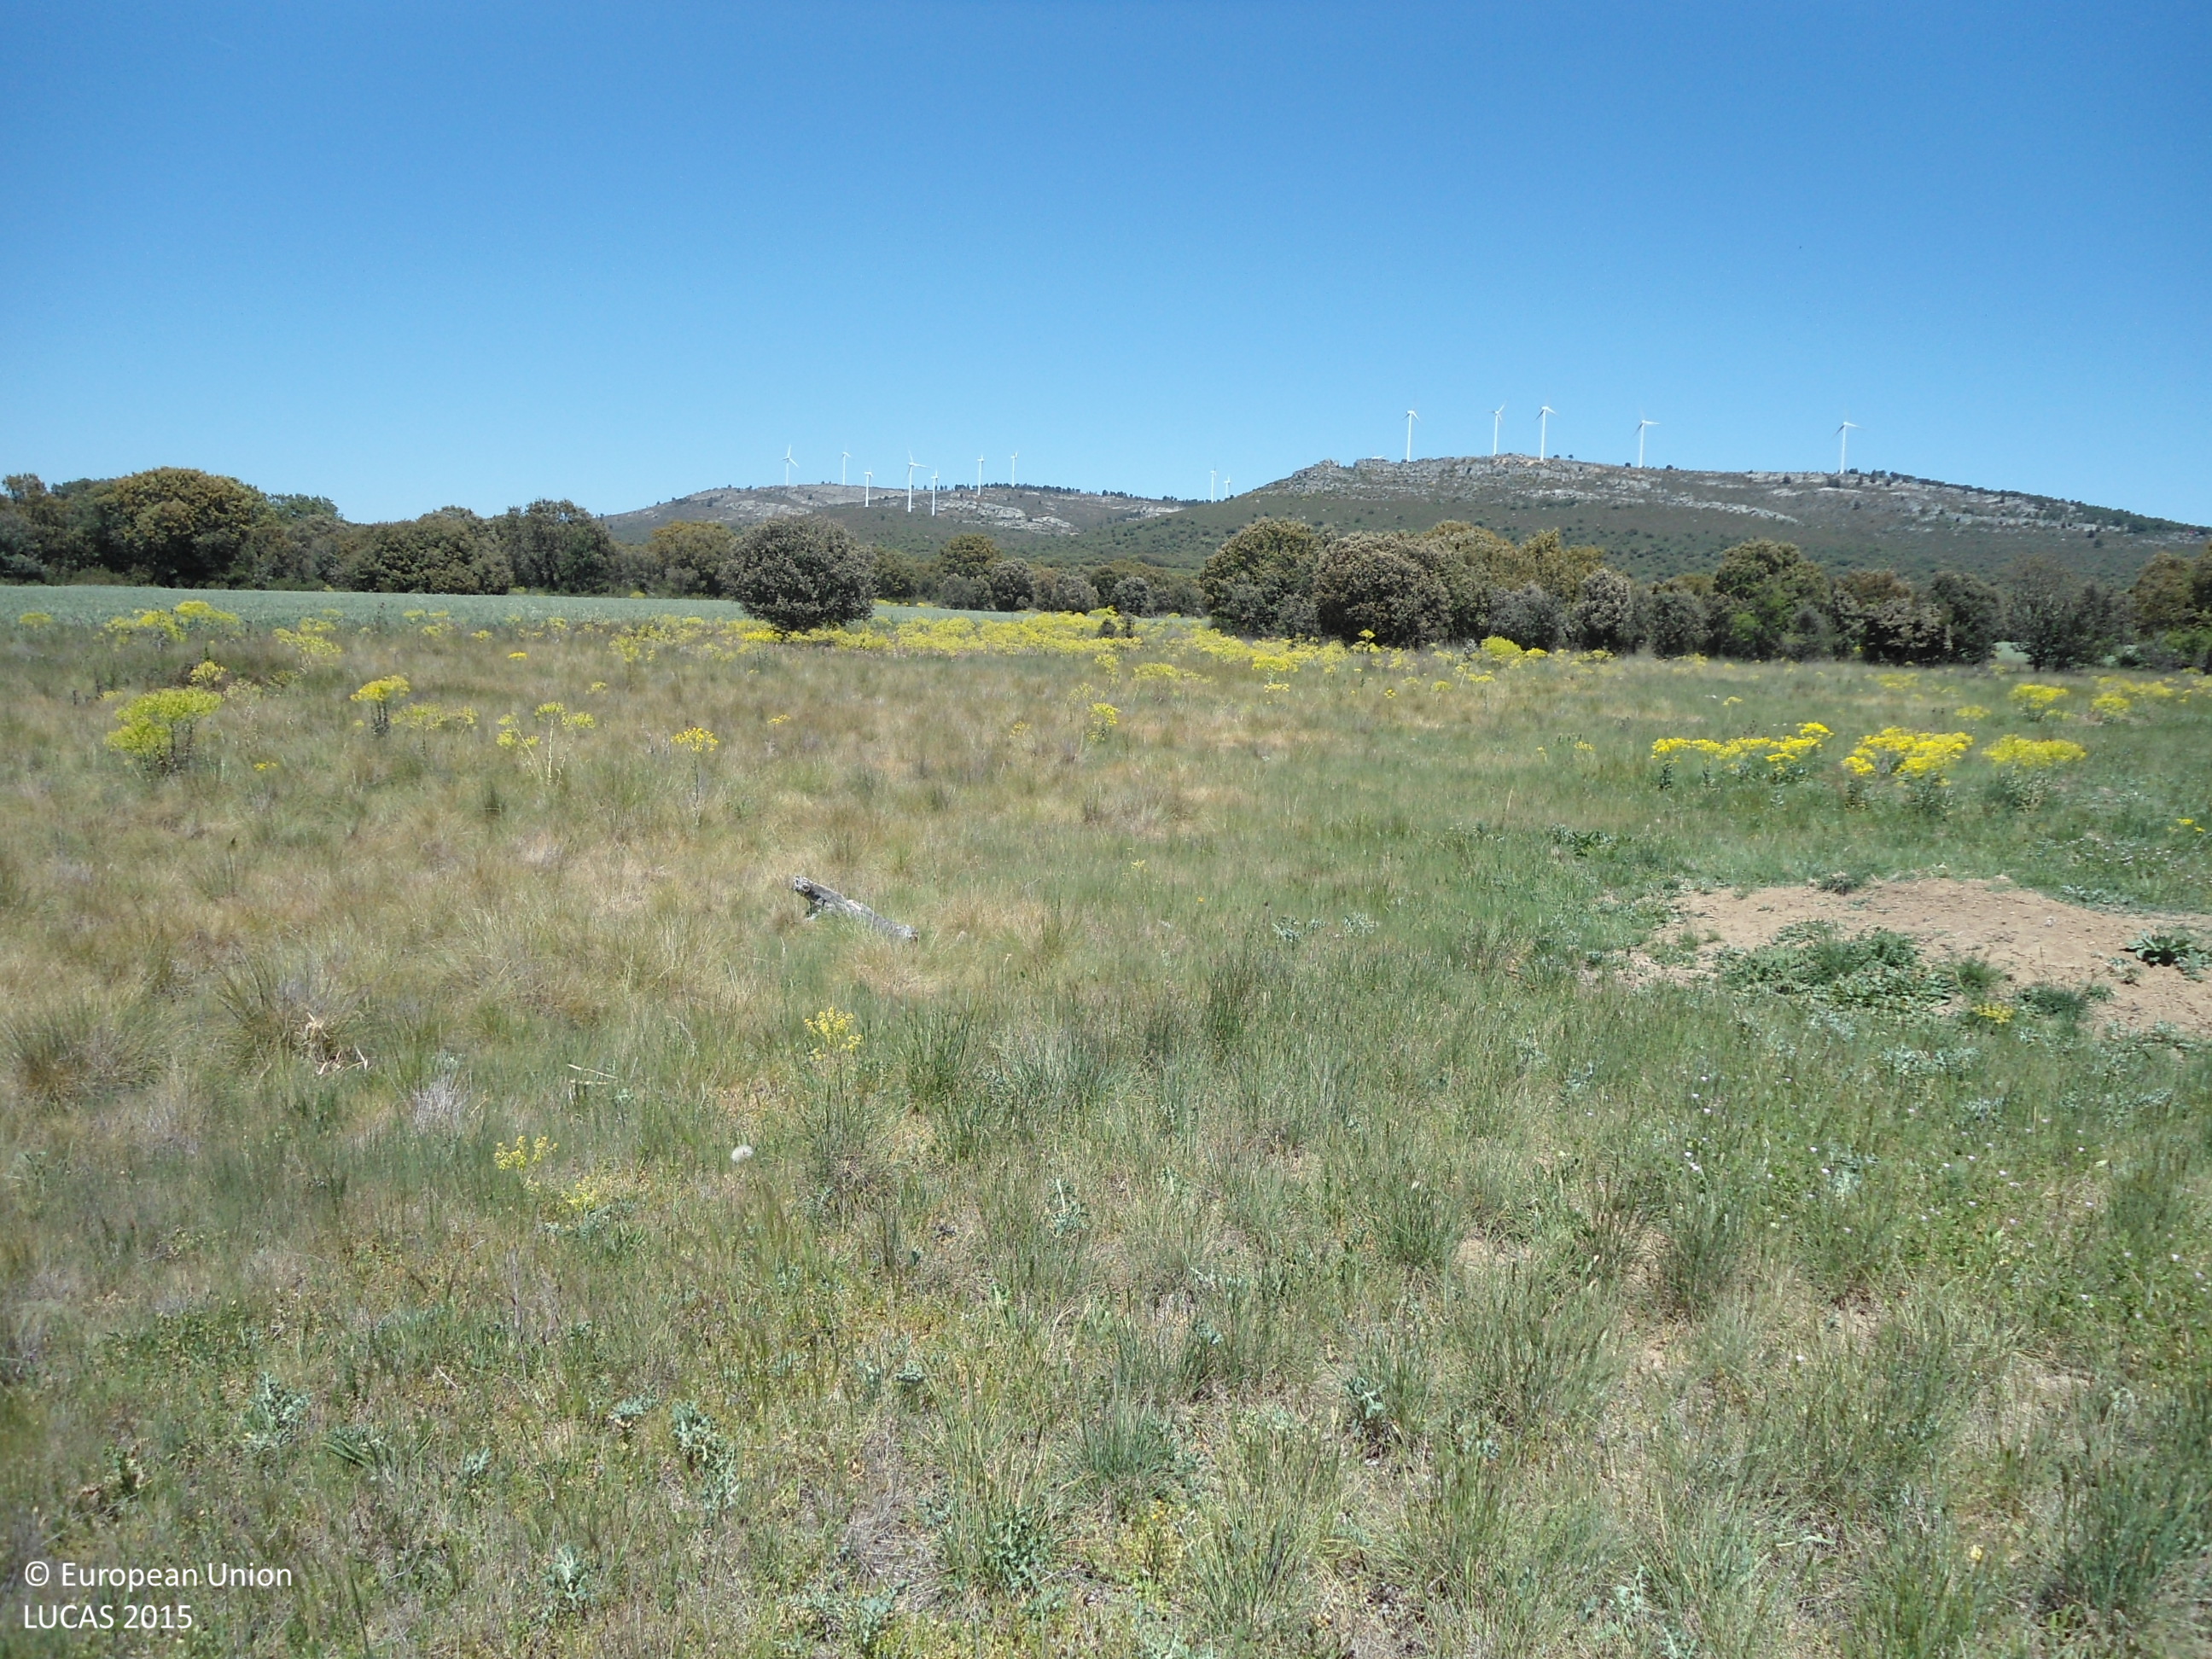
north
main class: Grassland
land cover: Grassland without tree/shrub cover
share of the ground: > 75 %
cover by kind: herbaceous plants 100 %
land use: Semi-natural and natural areas not in use
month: May
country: ES
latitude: 42.0971
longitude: -5.9504
